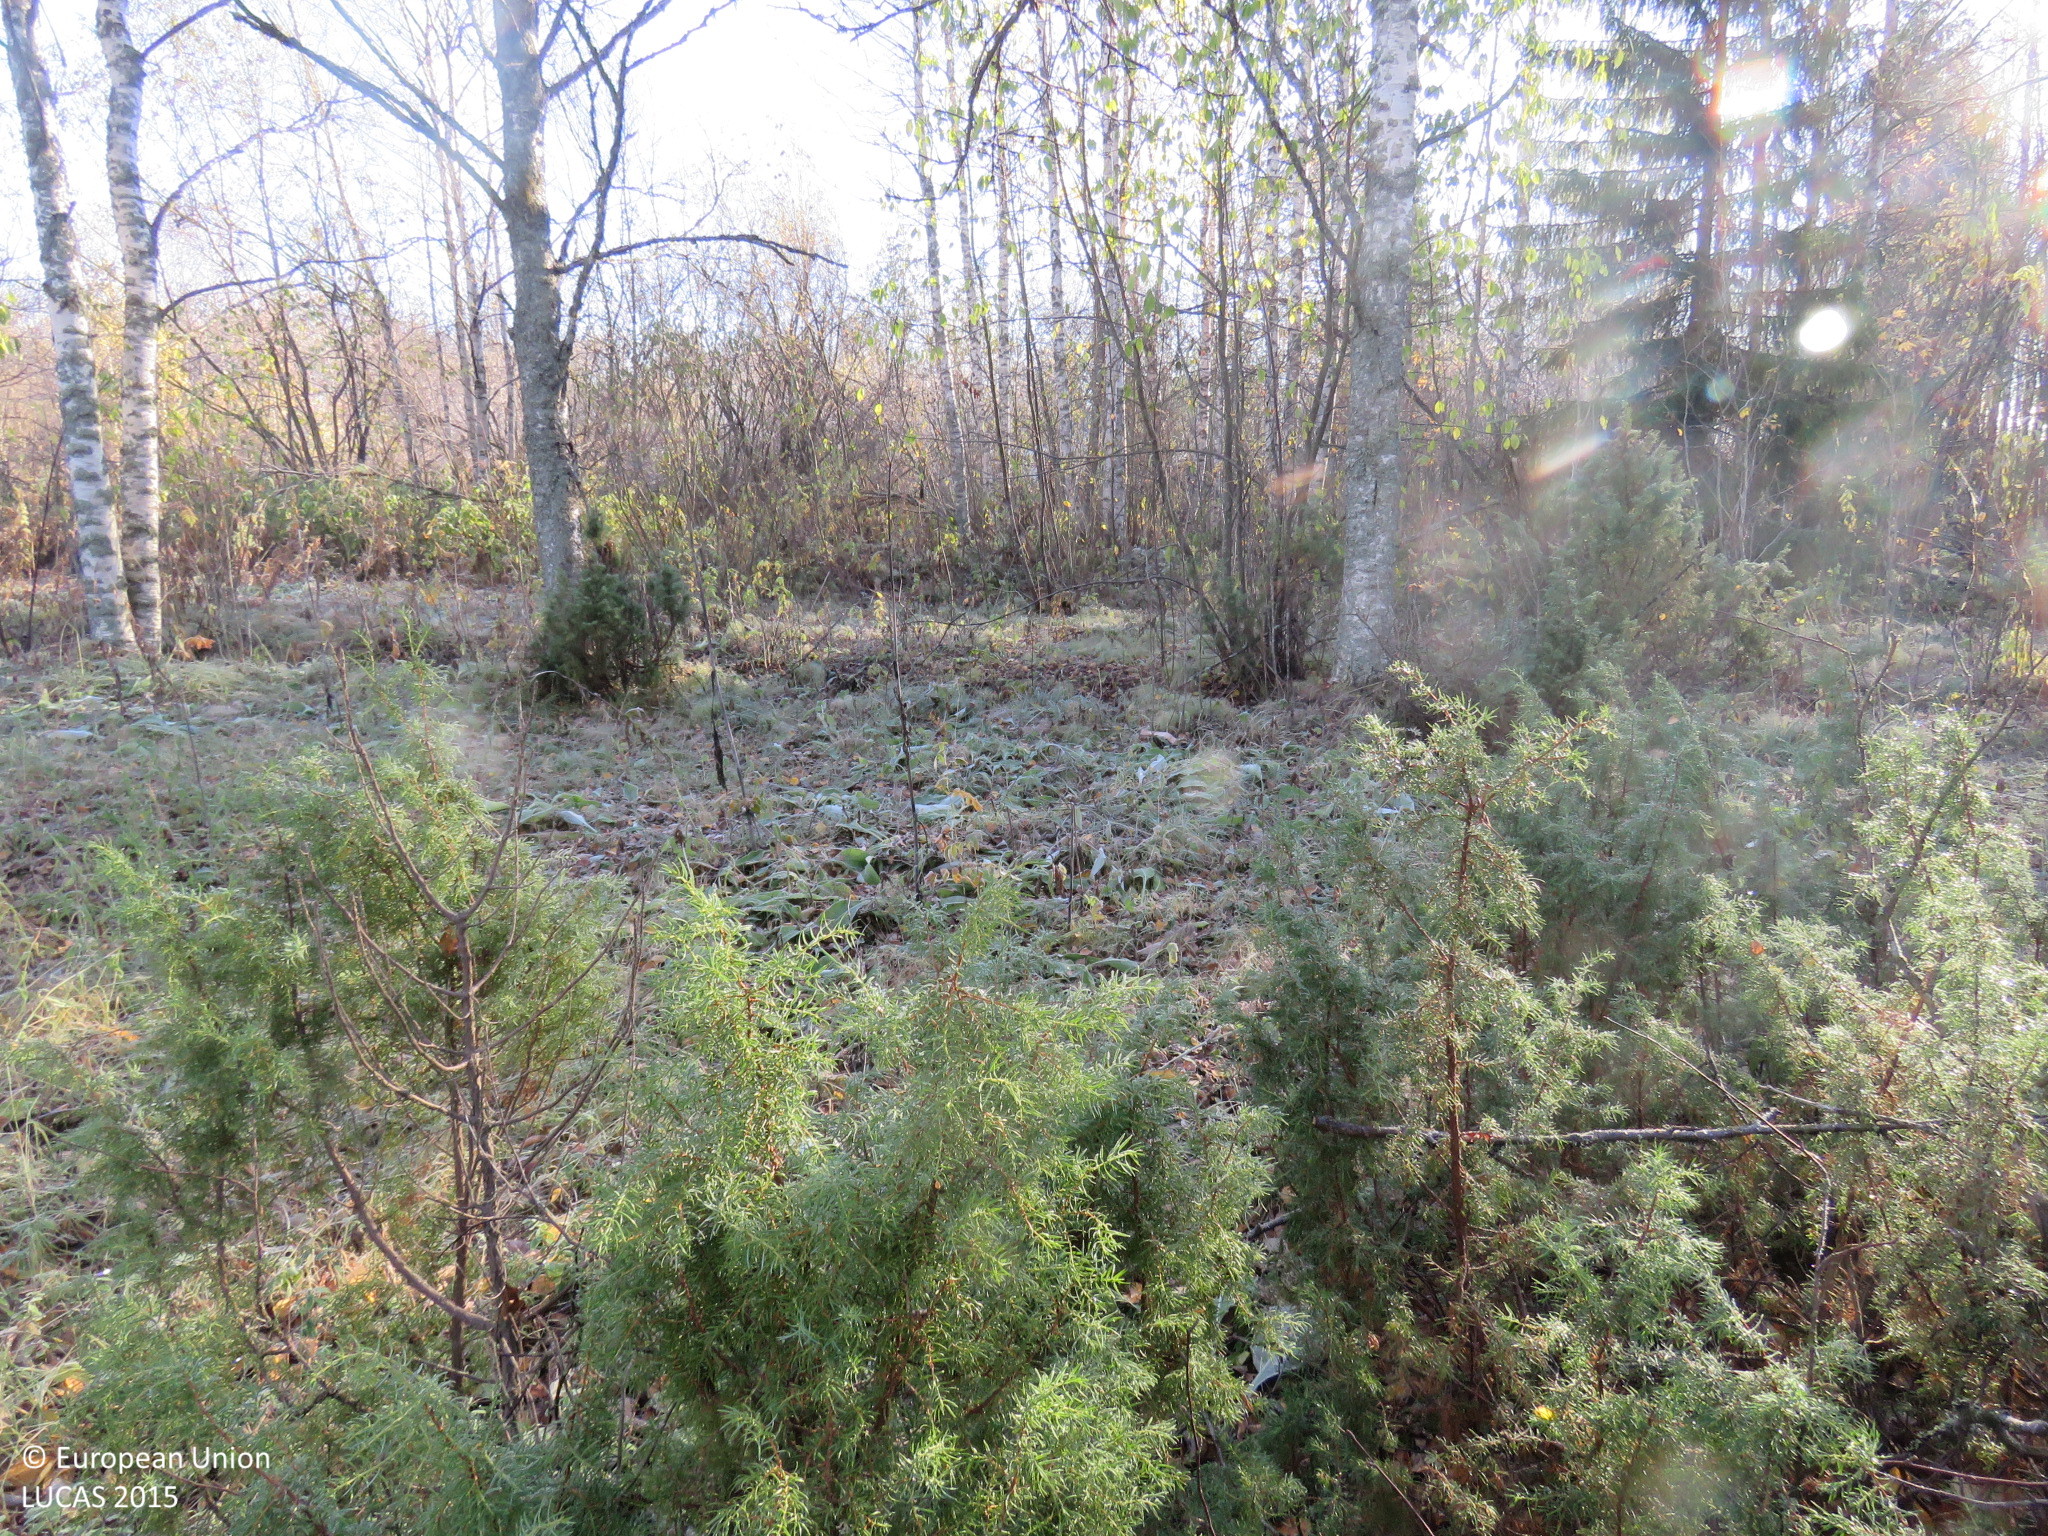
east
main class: Woodland
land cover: Broadleaved woodland
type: non-riverine alder, birch or aspen forest
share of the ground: > 75 %
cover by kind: broadleaved forest trees 80 %, herbaceous plants 10 %, coniferous forest trees 5 %, shrubs 5 %
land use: Forestry
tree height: > 5 m
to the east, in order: Ditches and canals; Broadleaved woodland; Ditches and canals; Broadleaved woodland; Ditches and canals; Broadleaved woodland; Ditches and canals; Broadleaved woodland; Grassland with sparse tree/shrub cover; Artificial constructions in urban areas; Broadleaved woodland; Grassland without tree/shrub cover; Electric lines; Broadleaved woodland; Grassland without tree/shrub cover; Broadleaved woodland
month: October
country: FI
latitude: 64.4297
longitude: 27.3968
